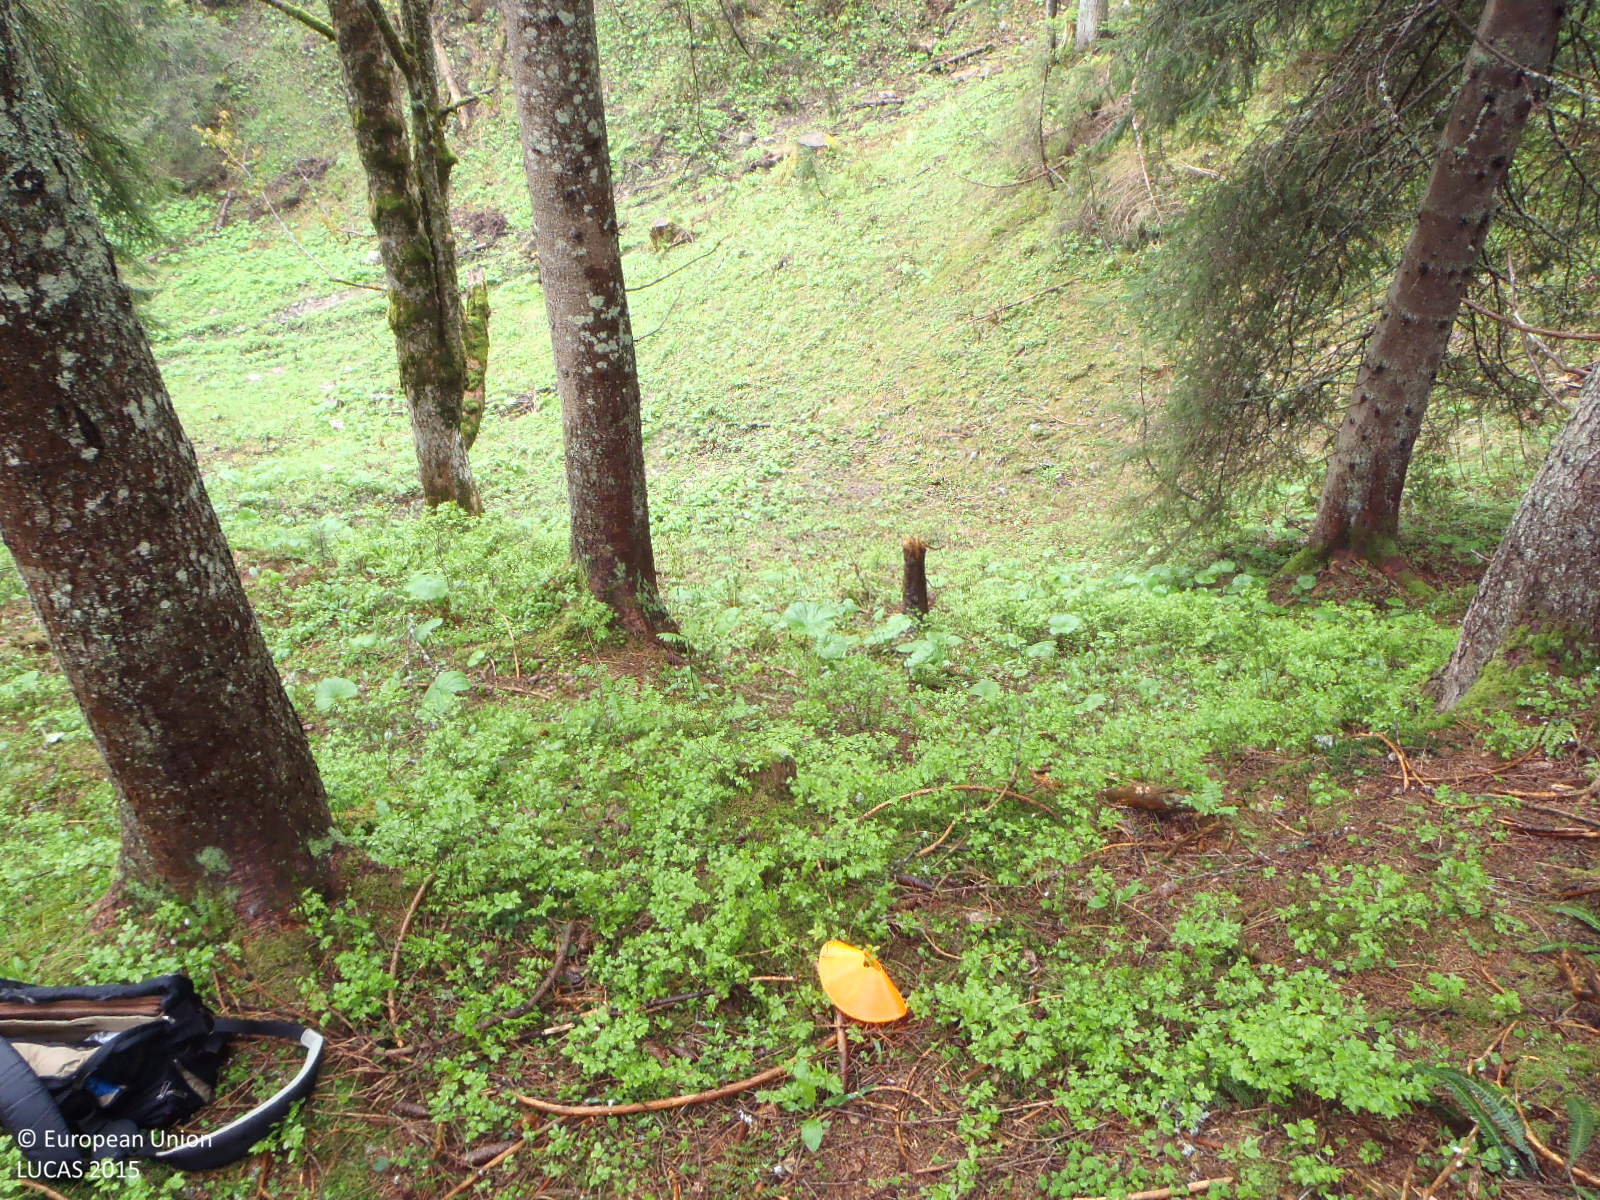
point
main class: Woodland
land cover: Spruce dominated coniferous woodland
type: alpine coniferous forest
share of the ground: > 75 %
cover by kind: coniferous forest trees 85 %, shrubs 5 %, herbaceous plants 5 %, lichens and mosses 5 %
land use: Forestry
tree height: > 5 m
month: May
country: AT
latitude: 47.6169
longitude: 12.5928
